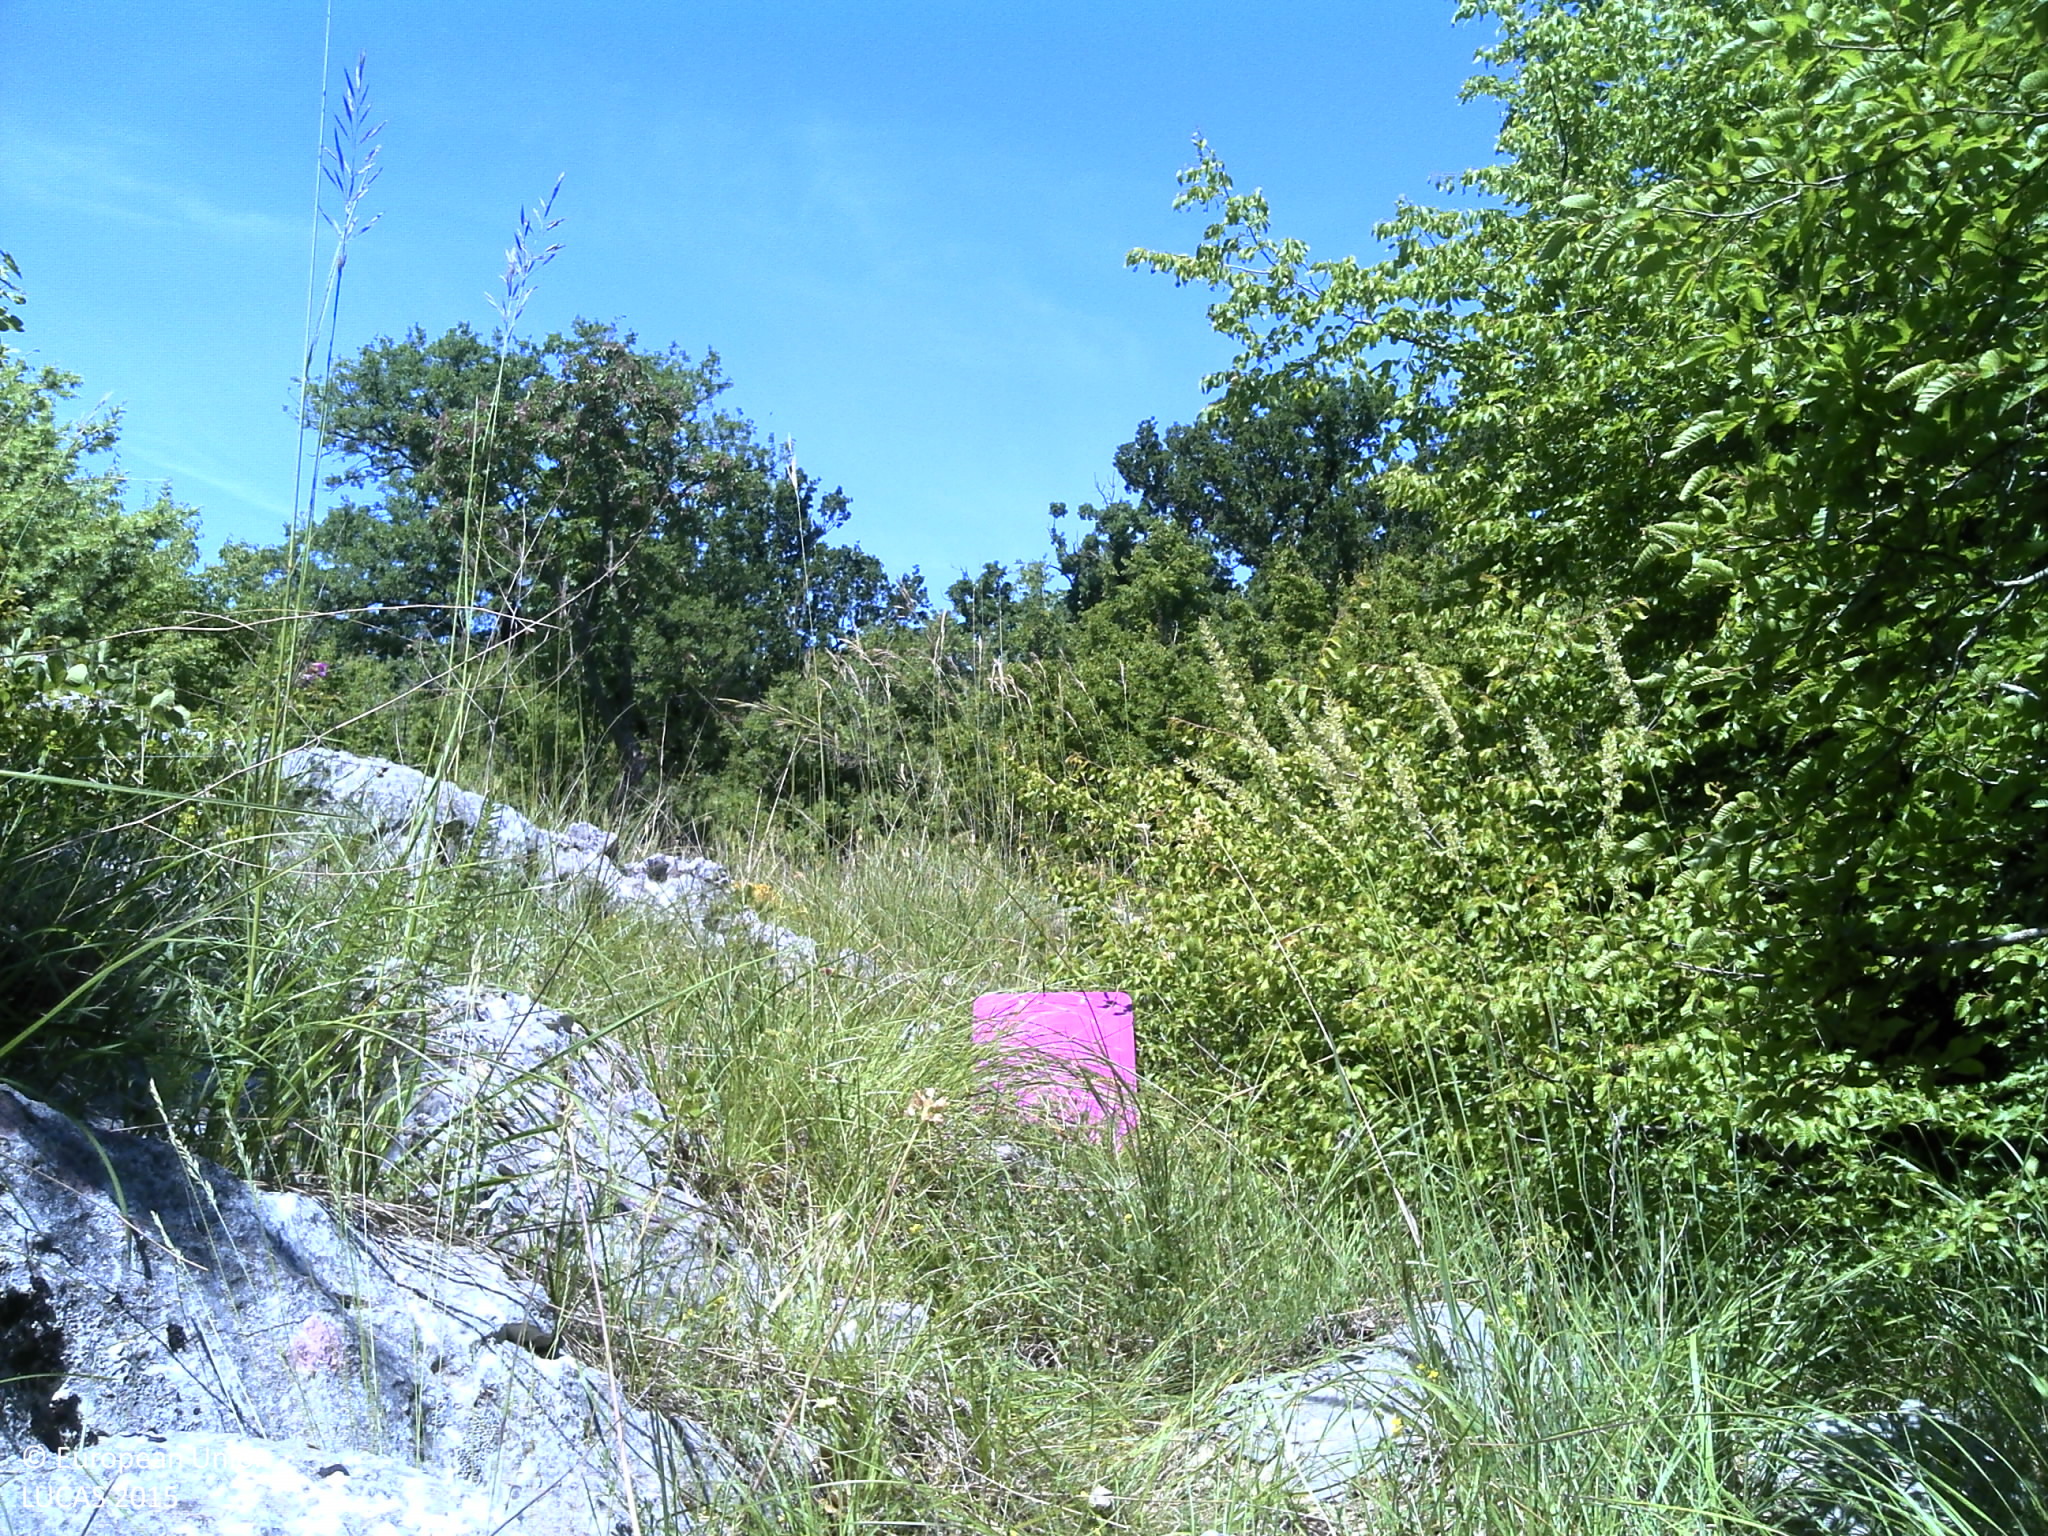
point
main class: Woodland
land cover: Broadleaved woodland
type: thermophilous deciduous forest
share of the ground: > 75 %
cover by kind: broadleaved forest trees 75 %, herbaceous plants 15 %, shrubs 5 %, unconsolidated bare surface 5 %
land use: Semi-natural and natural areas not in use
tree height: < 5 m
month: June
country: HR
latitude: 43.7468
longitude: 16.2378
